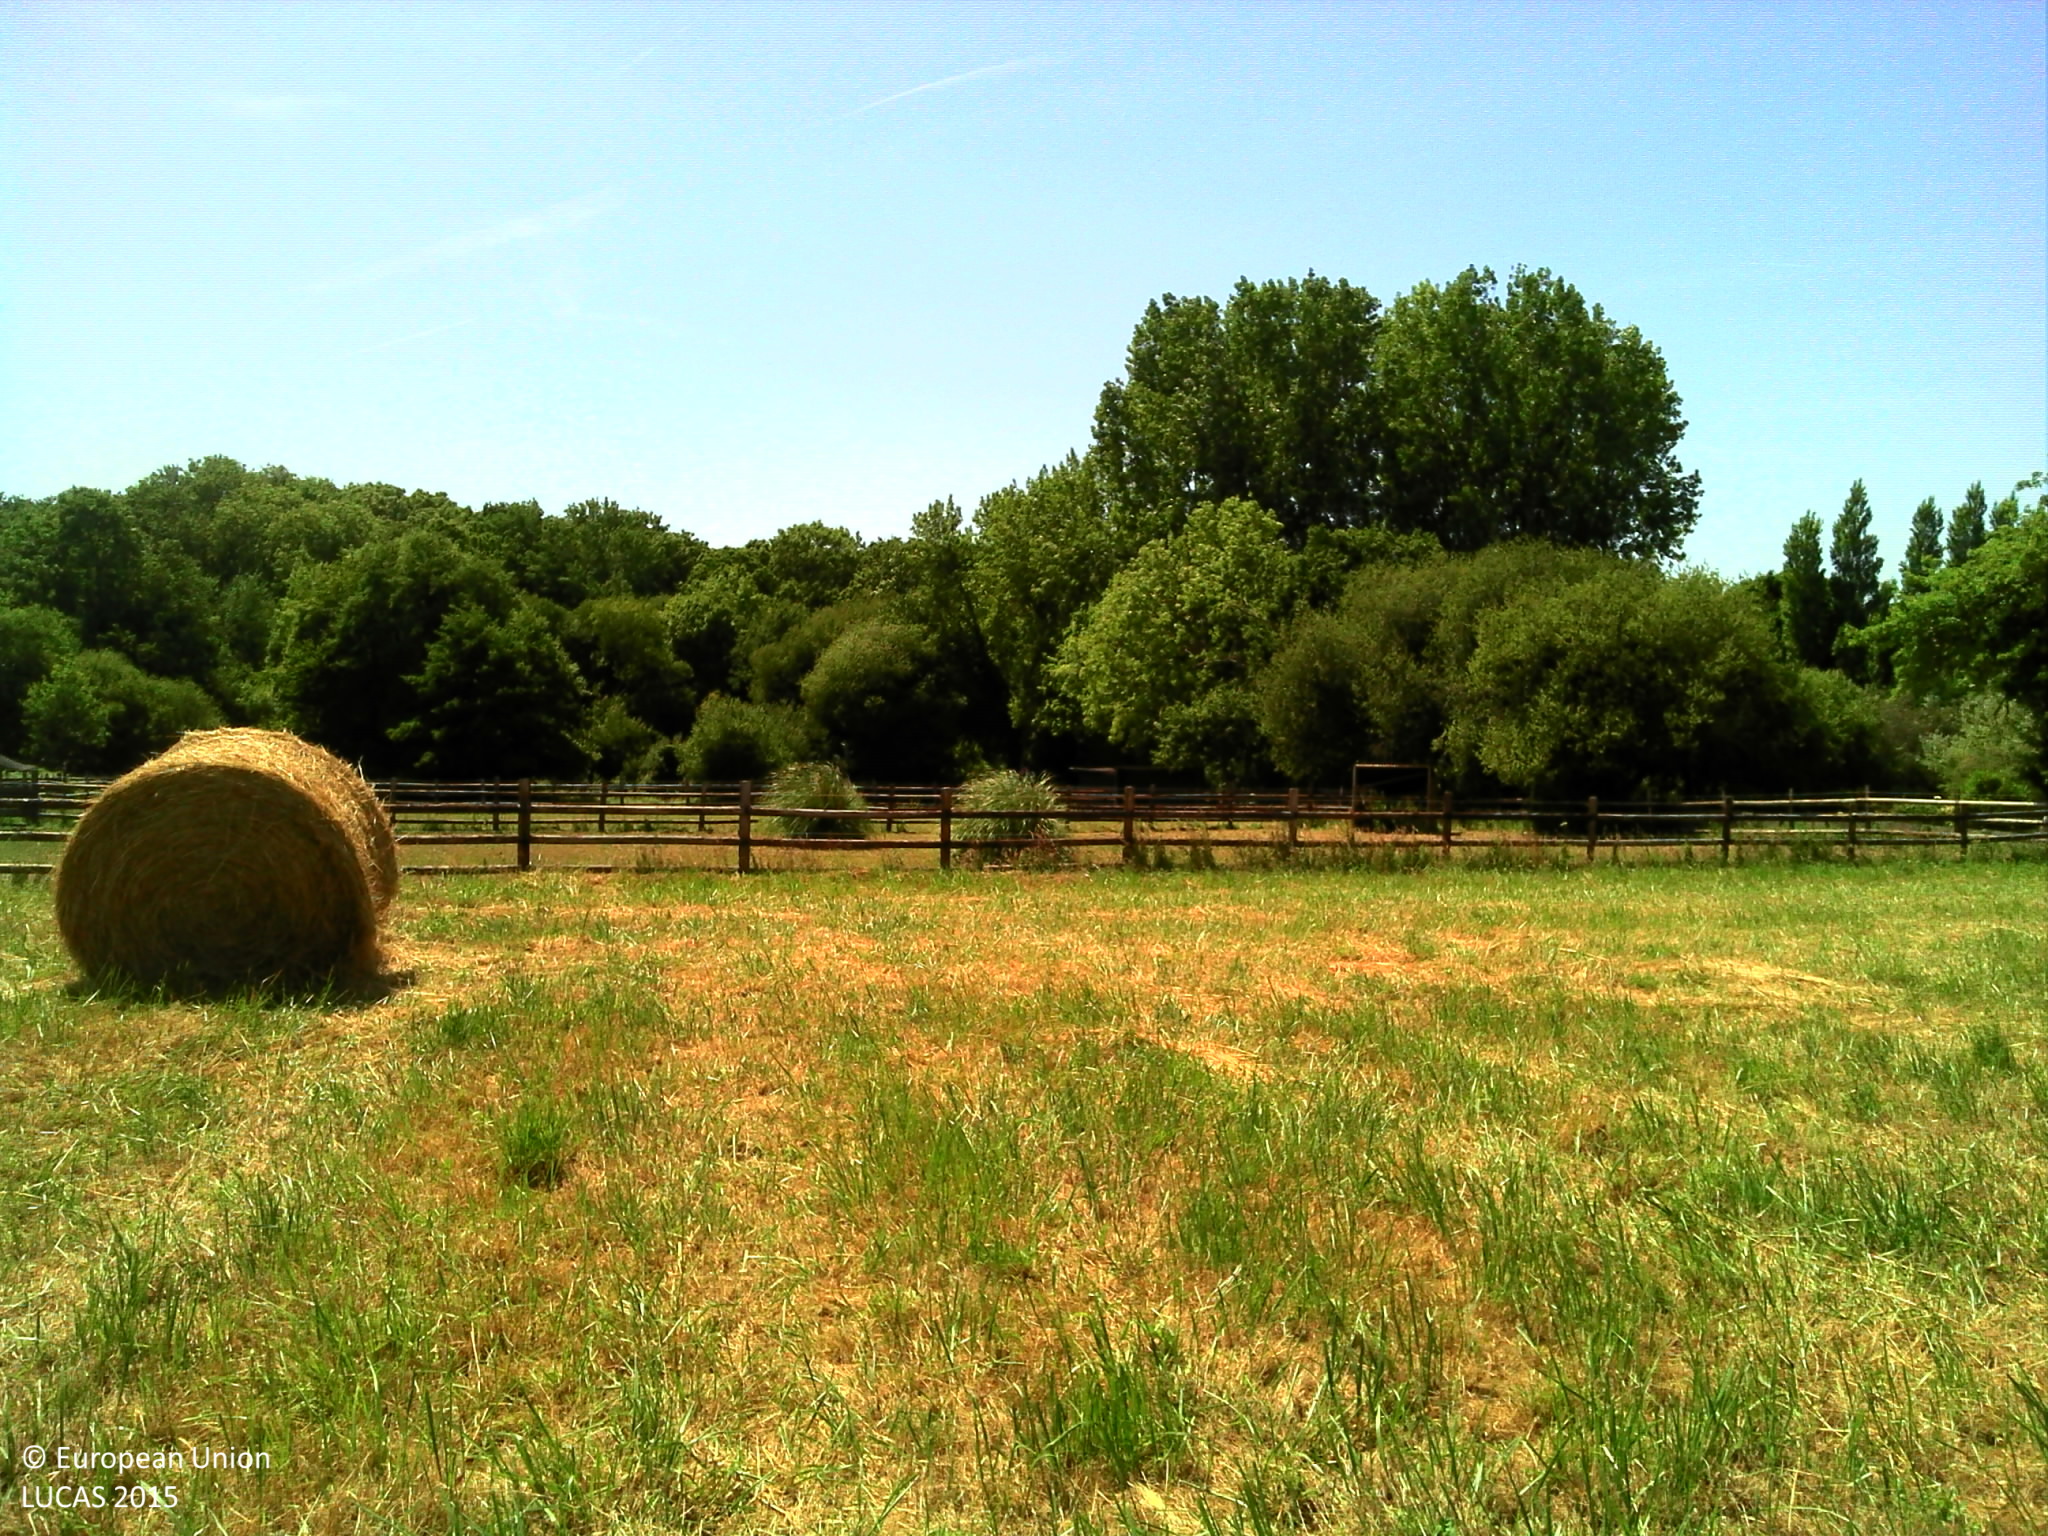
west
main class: Cropland
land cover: Temporary grasslands
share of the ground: > 75 %
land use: Agriculture (excluding fallow land and kitchen gardens)
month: June
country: FR
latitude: 48.6256
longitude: -2.1175
